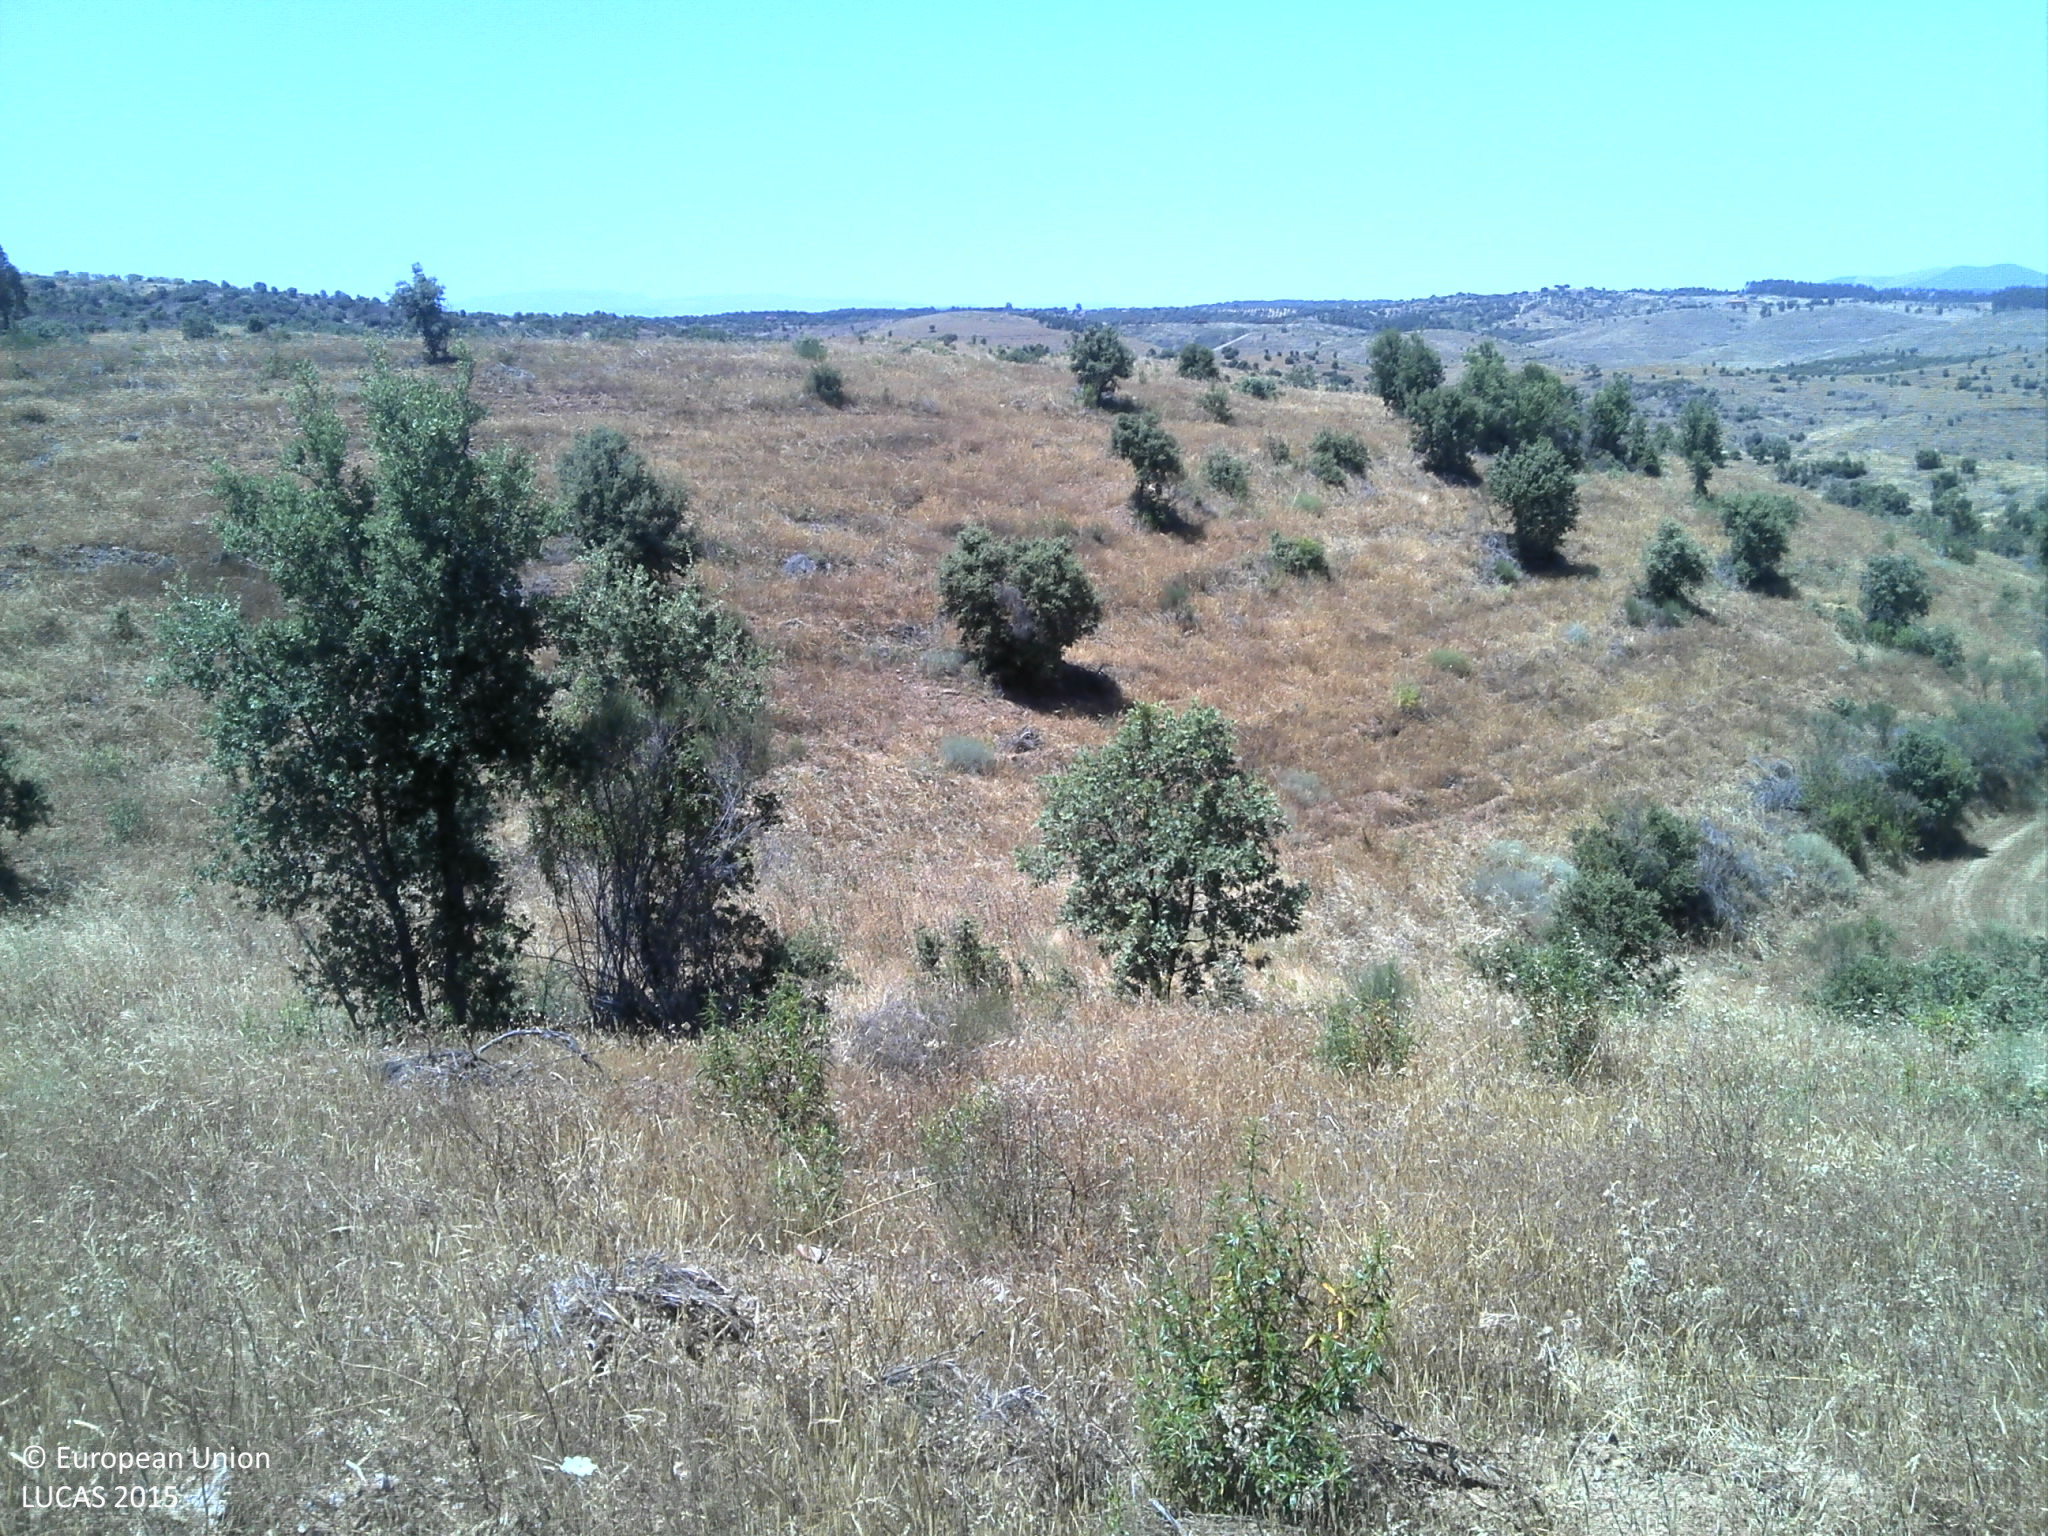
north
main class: Grassland
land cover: Grassland with sparse tree/shrub cover
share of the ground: 50 - 75 %
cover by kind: herbaceous plants 60 %, unconsolidated bare surface 20 %, broadleaved forest trees 5 %, shrubs 5 %
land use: Agriculture (excluding fallow land and kitchen gardens)
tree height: > 5 m
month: June
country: PT
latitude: 39.9848
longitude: -7.2282
